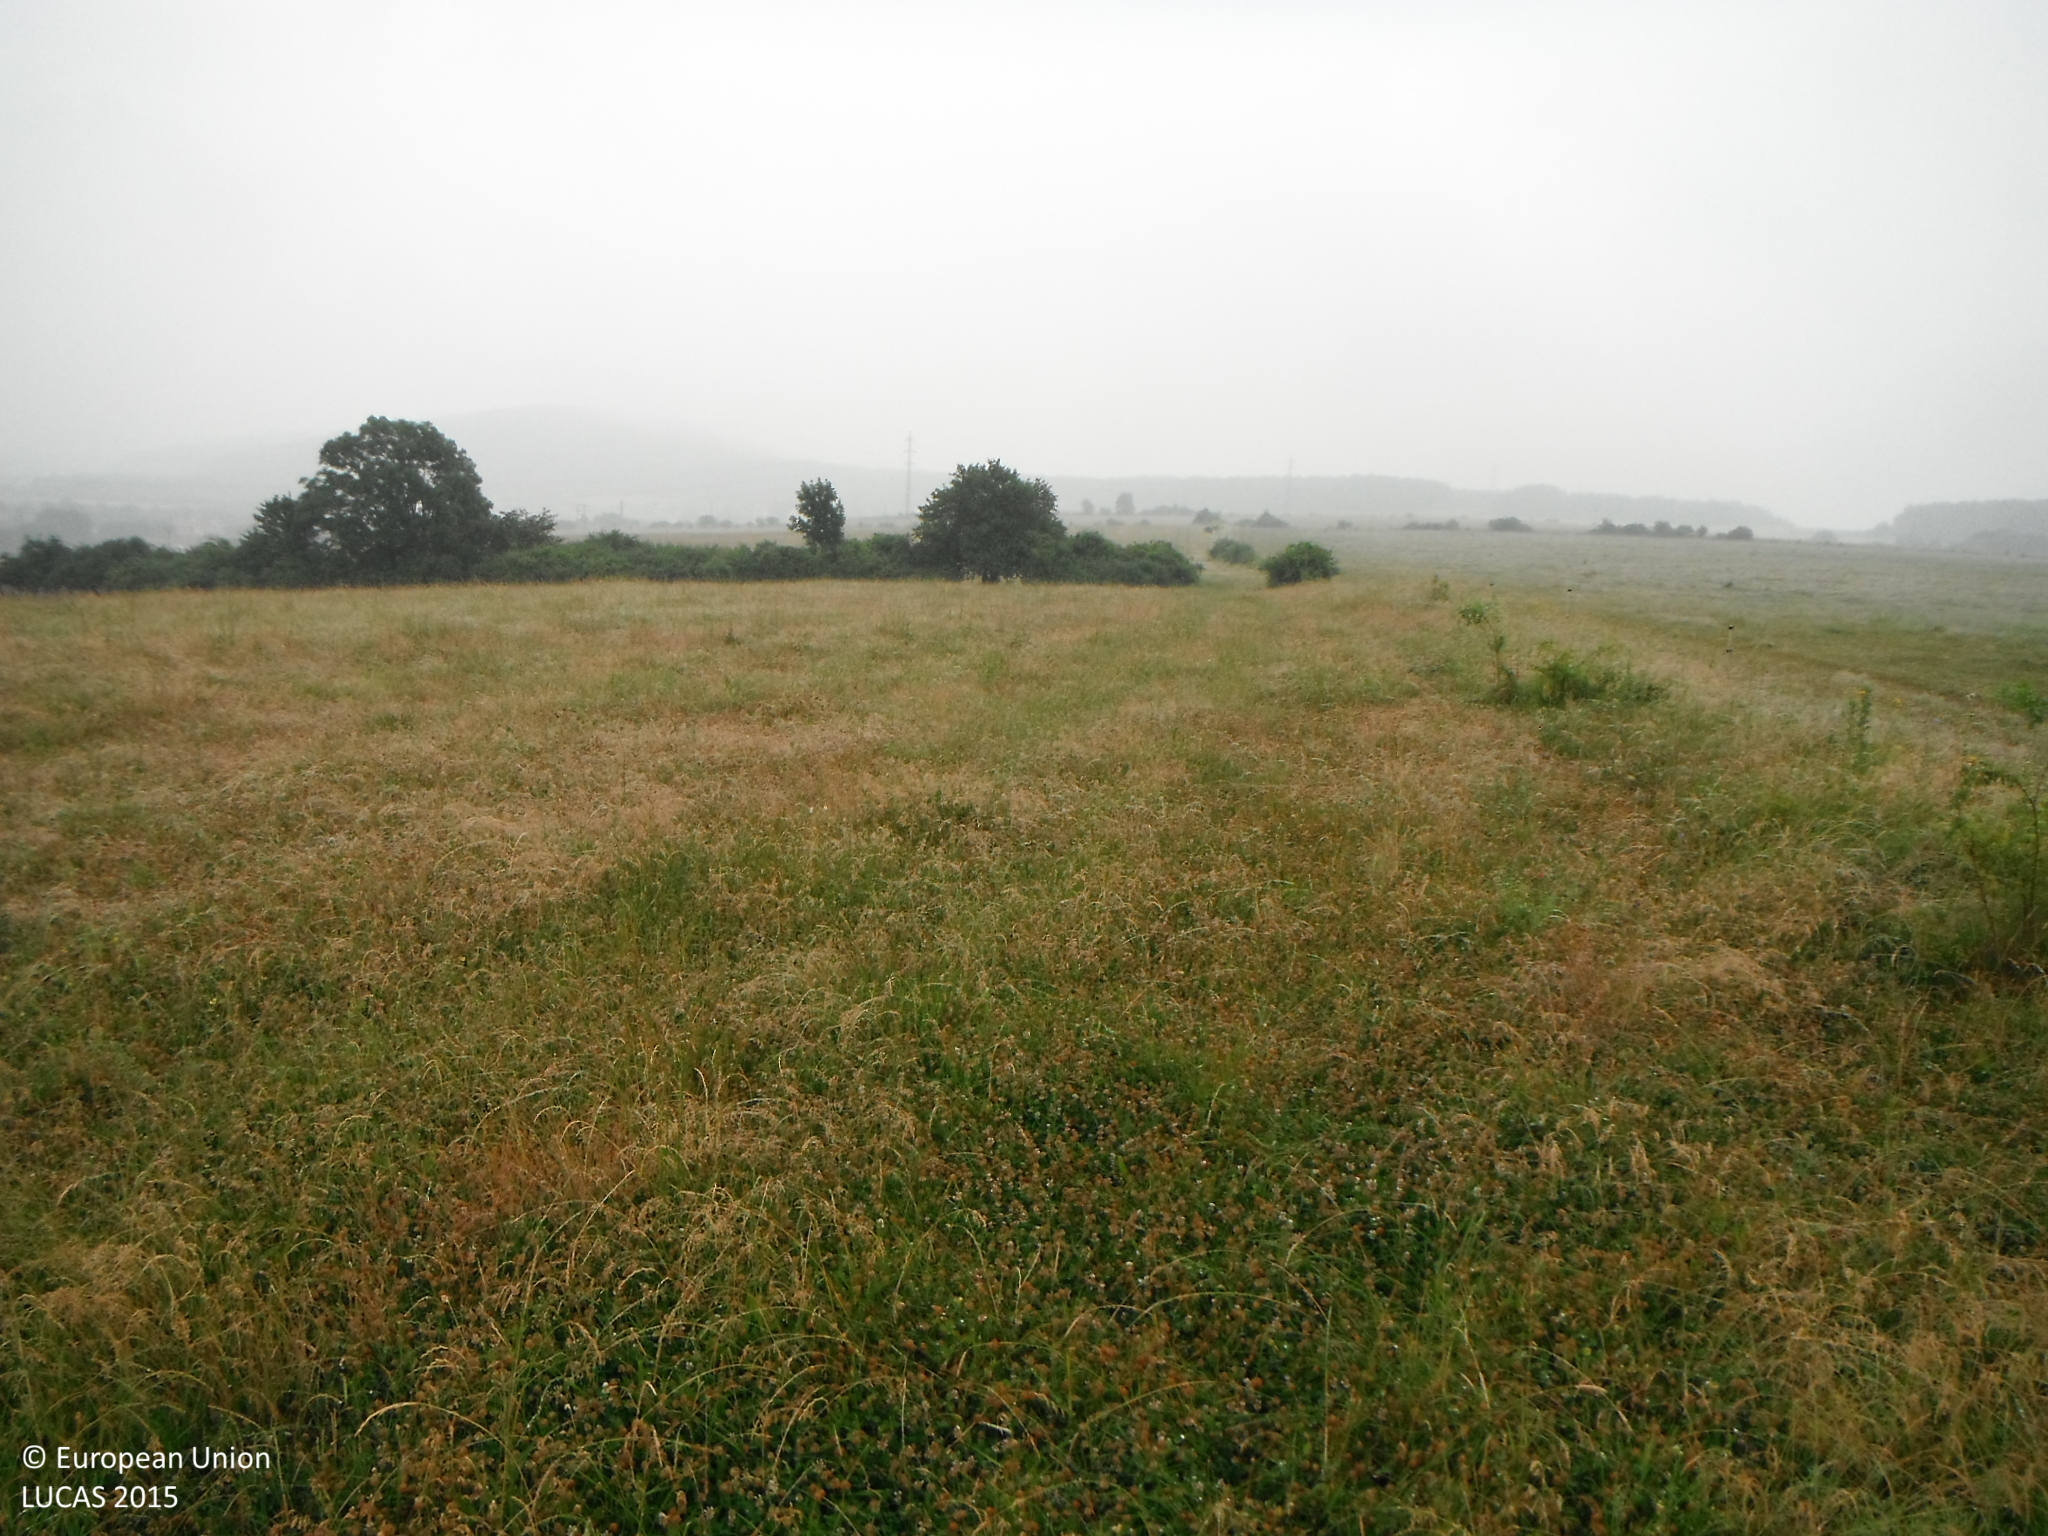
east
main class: Grassland
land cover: Grassland without tree/shrub cover
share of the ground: > 75 %
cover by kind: herbaceous plants 100 %
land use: Agriculture (excluding fallow land and kitchen gardens)
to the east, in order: Grassland without tree/shrub cover; Tracks; Grassland without tree/shrub cover; Shrubland with sparse tree cover; Grassland without tree/shrub cover
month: June
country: SK
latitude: 48.1235
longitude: 19.0345
